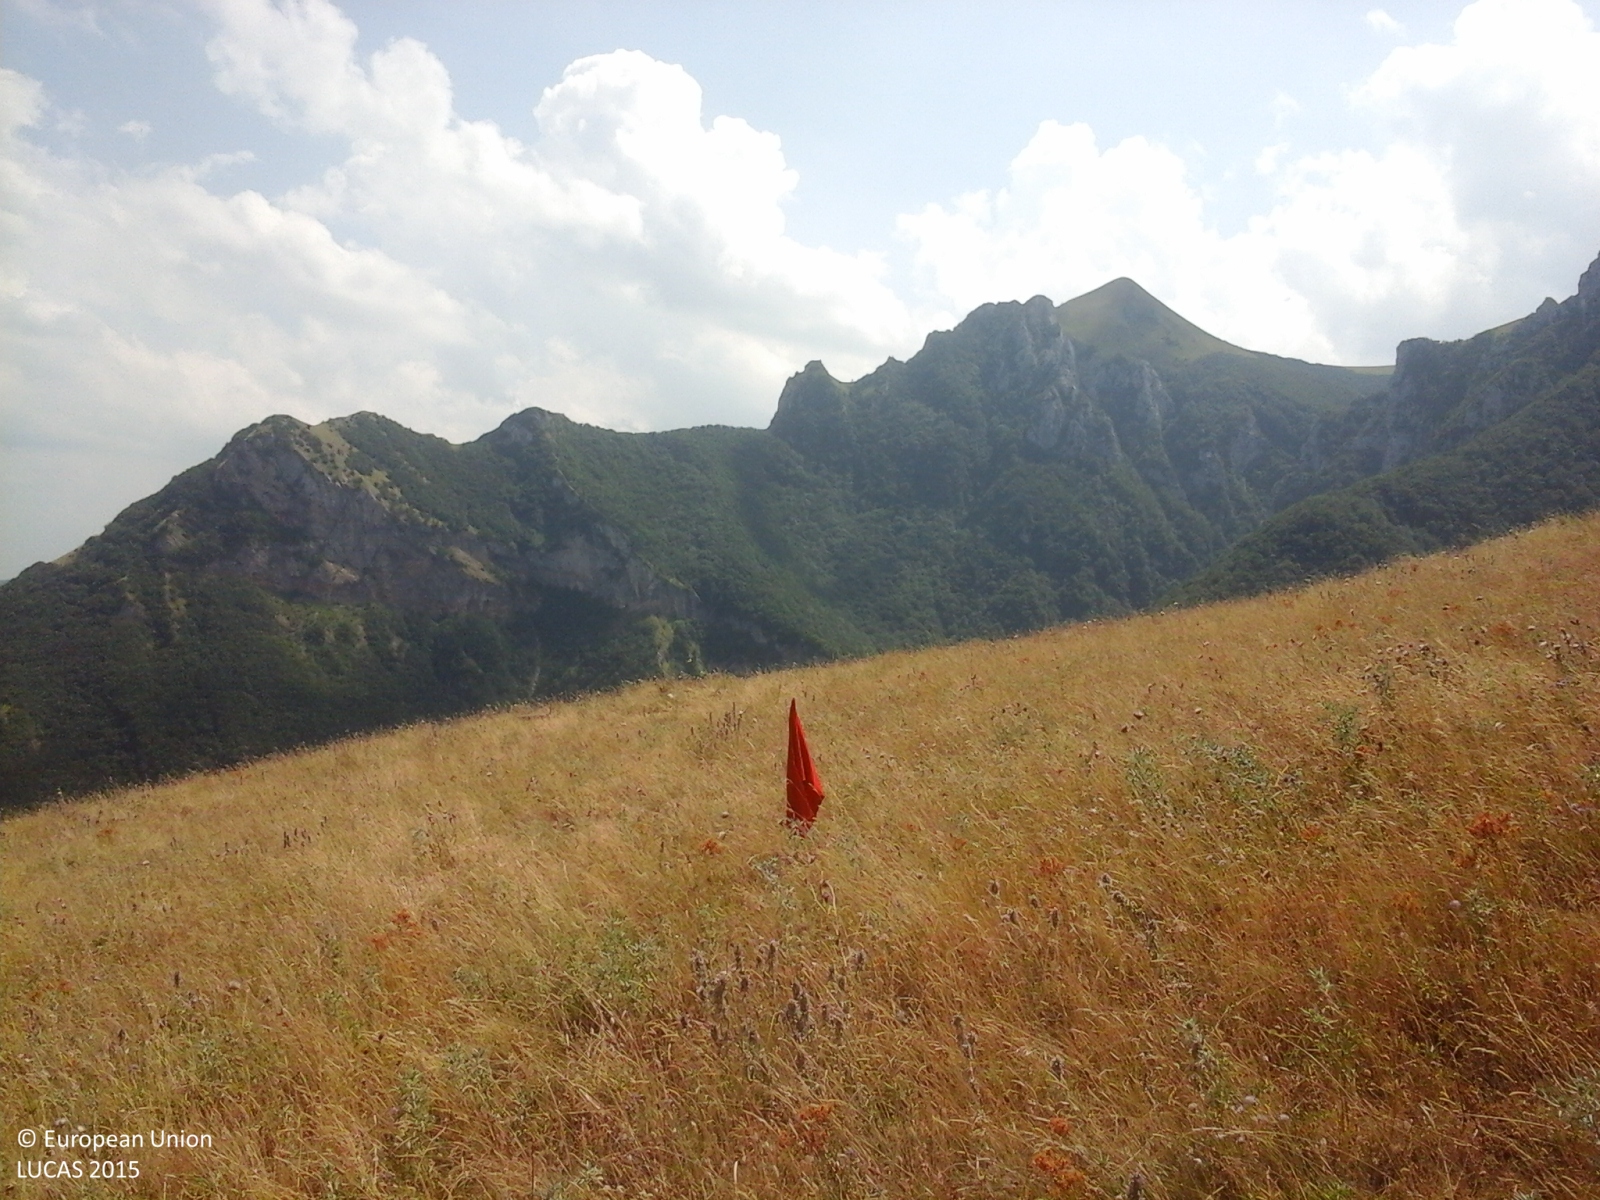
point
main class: Grassland
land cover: Grassland without tree/shrub cover
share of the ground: > 75 %
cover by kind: herbaceous plants 95 %, shrubs 5 %
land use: Agriculture (excluding fallow land and kitchen gardens)
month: July
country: IT
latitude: 43.0358
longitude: 13.2435
